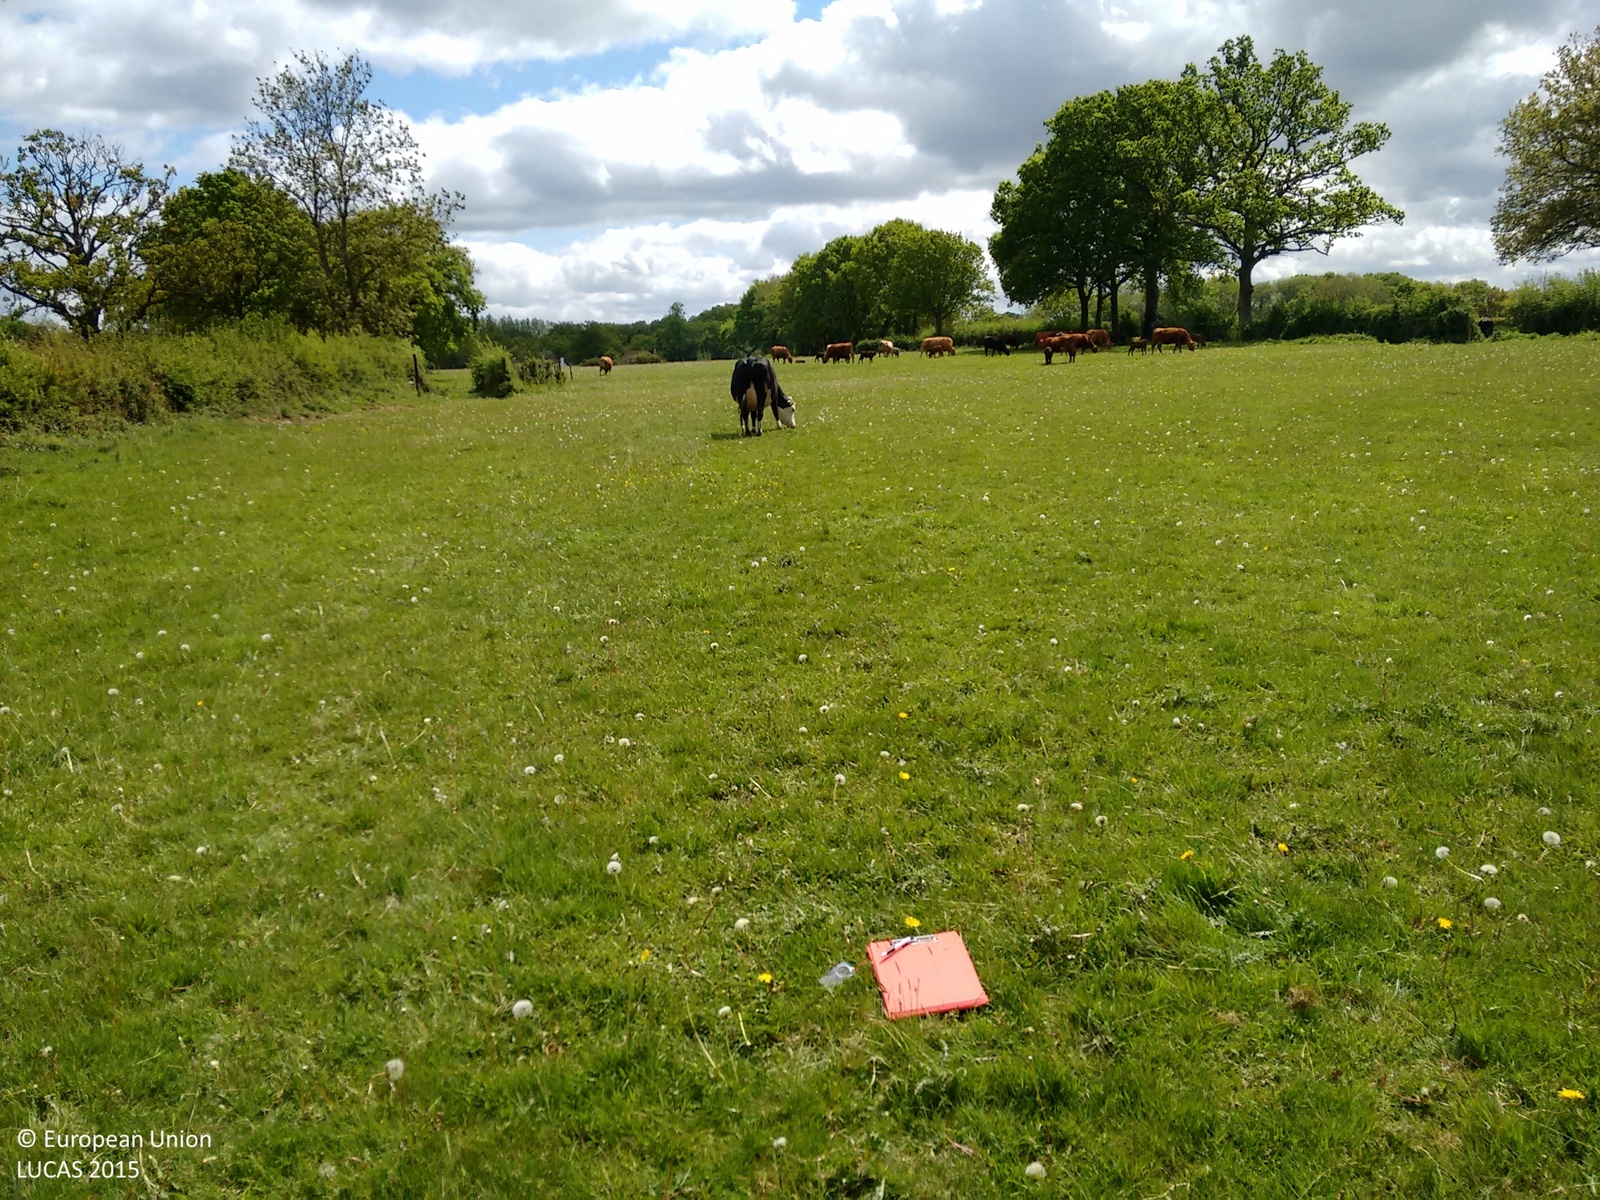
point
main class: Grassland
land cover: Grassland without tree/shrub cover
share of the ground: > 75 %
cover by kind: herbaceous plants 100 %
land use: Agriculture (excluding fallow land and kitchen gardens)
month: May
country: GB
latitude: 51.3399
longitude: -1.1719
